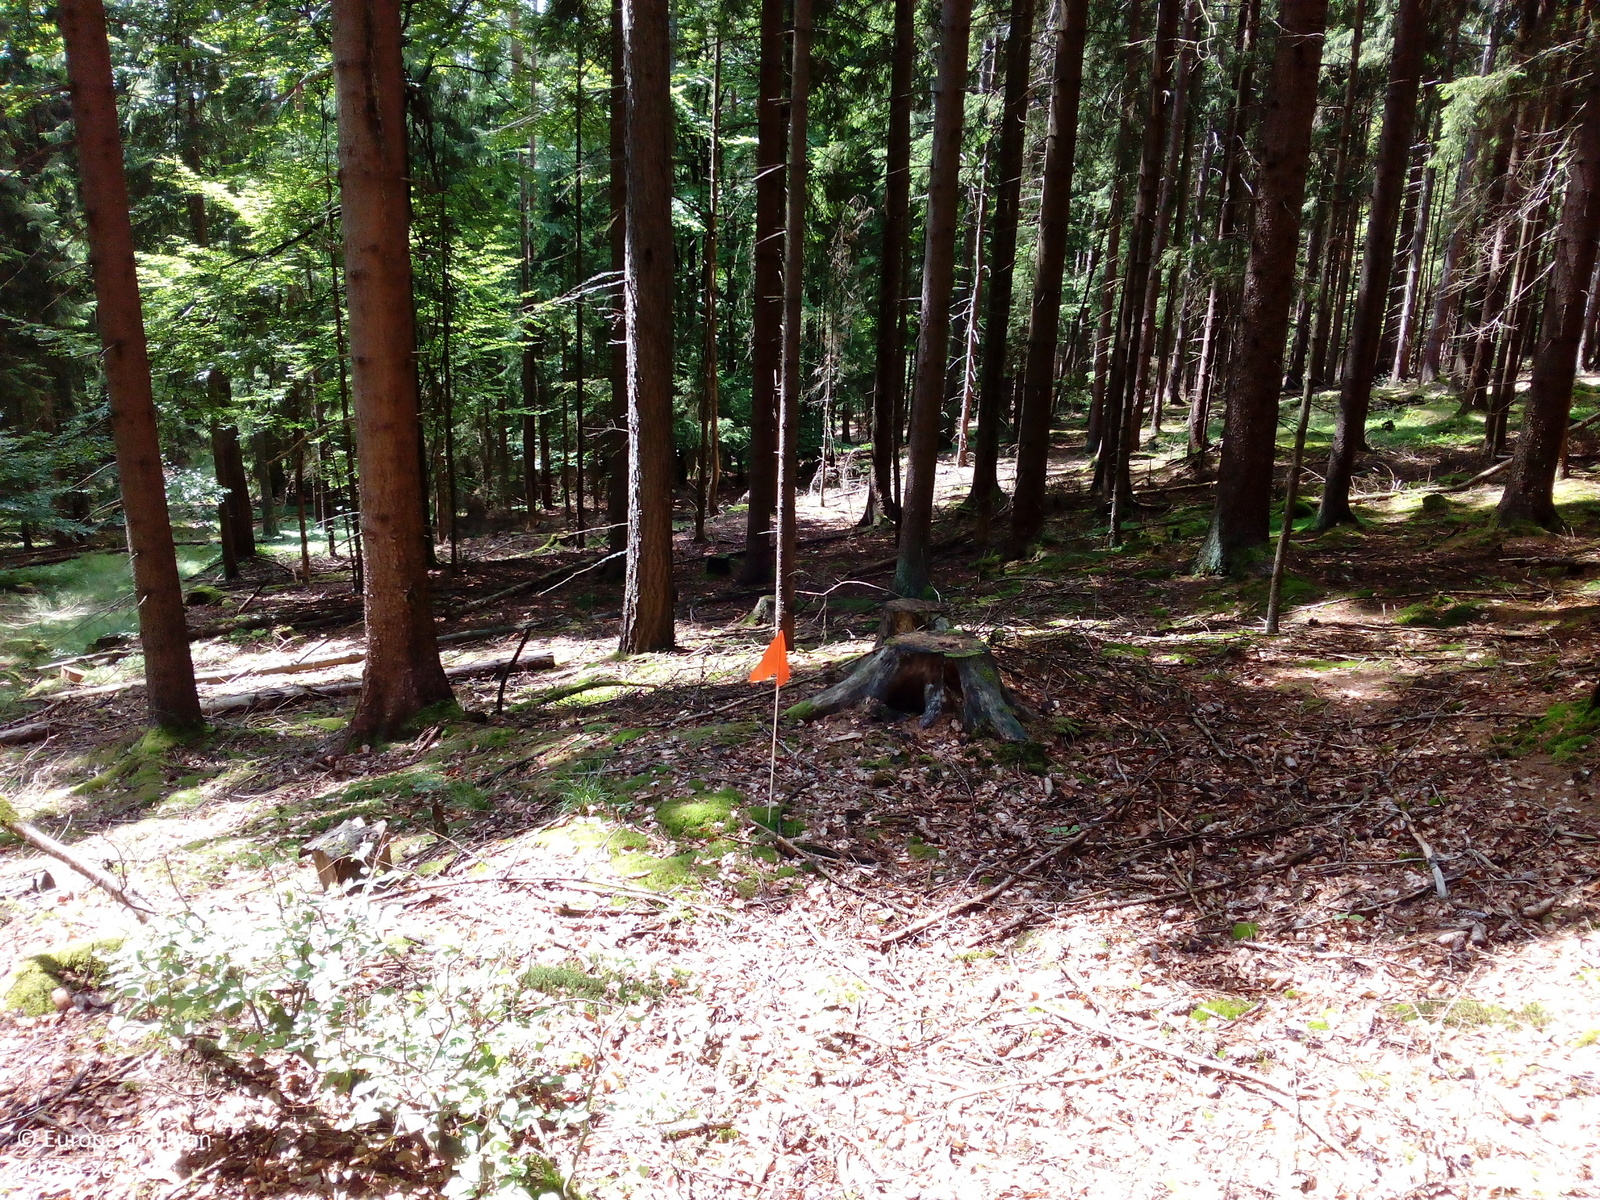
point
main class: Woodland
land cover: Spruce dominated coniferous woodland
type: hemiboreal forest and nemoral coniferous forest and mixed broadleaved-coniferous forest
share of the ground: > 75 %
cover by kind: coniferous forest trees 65 %, broadleaved forest trees 15 %, lichens and mosses 10 %, unconsolidated bare surface 10 %
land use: Forestry
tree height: > 5 m
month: July
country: DE
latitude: 49.5121
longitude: 12.3613
